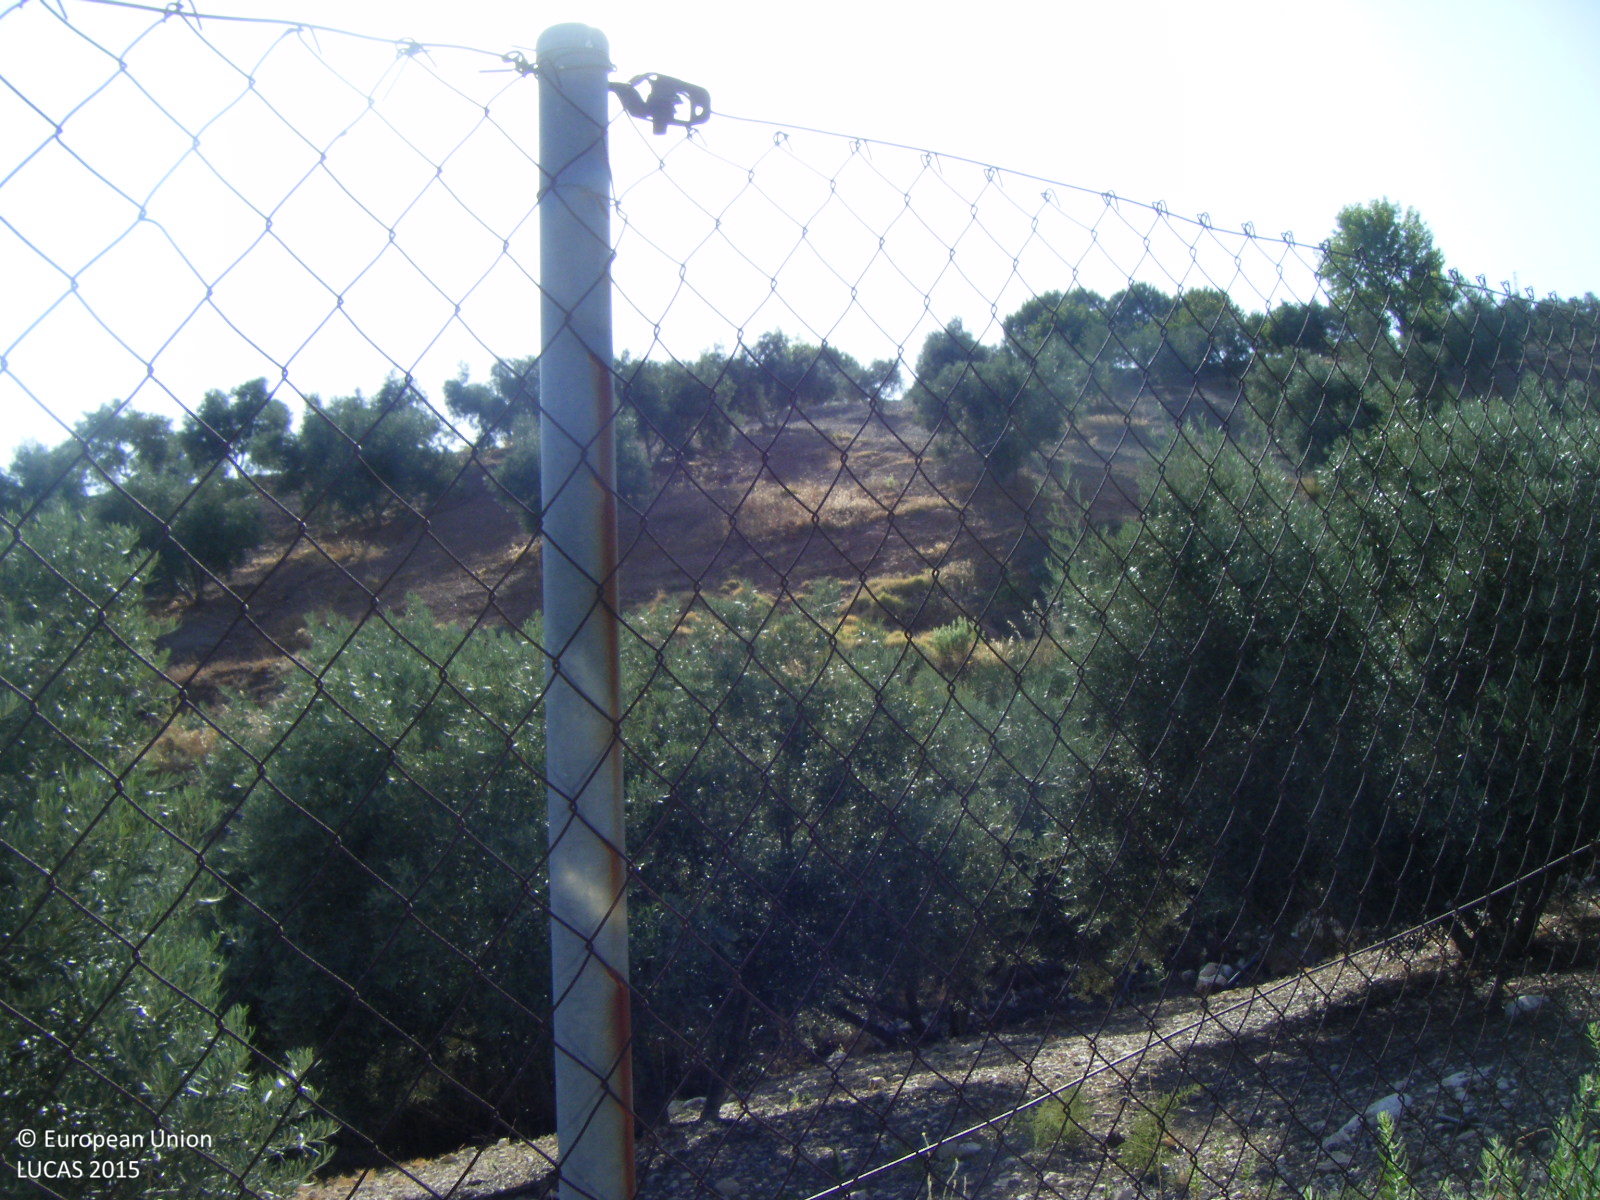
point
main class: Cropland
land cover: Olive groves
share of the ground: 10 - 25 %
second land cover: Spontaneously vegetated surfaces
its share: > 75 %
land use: Agriculture (excluding fallow land and kitchen gardens)
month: July
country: ES
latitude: 36.9431
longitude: -4.3772
